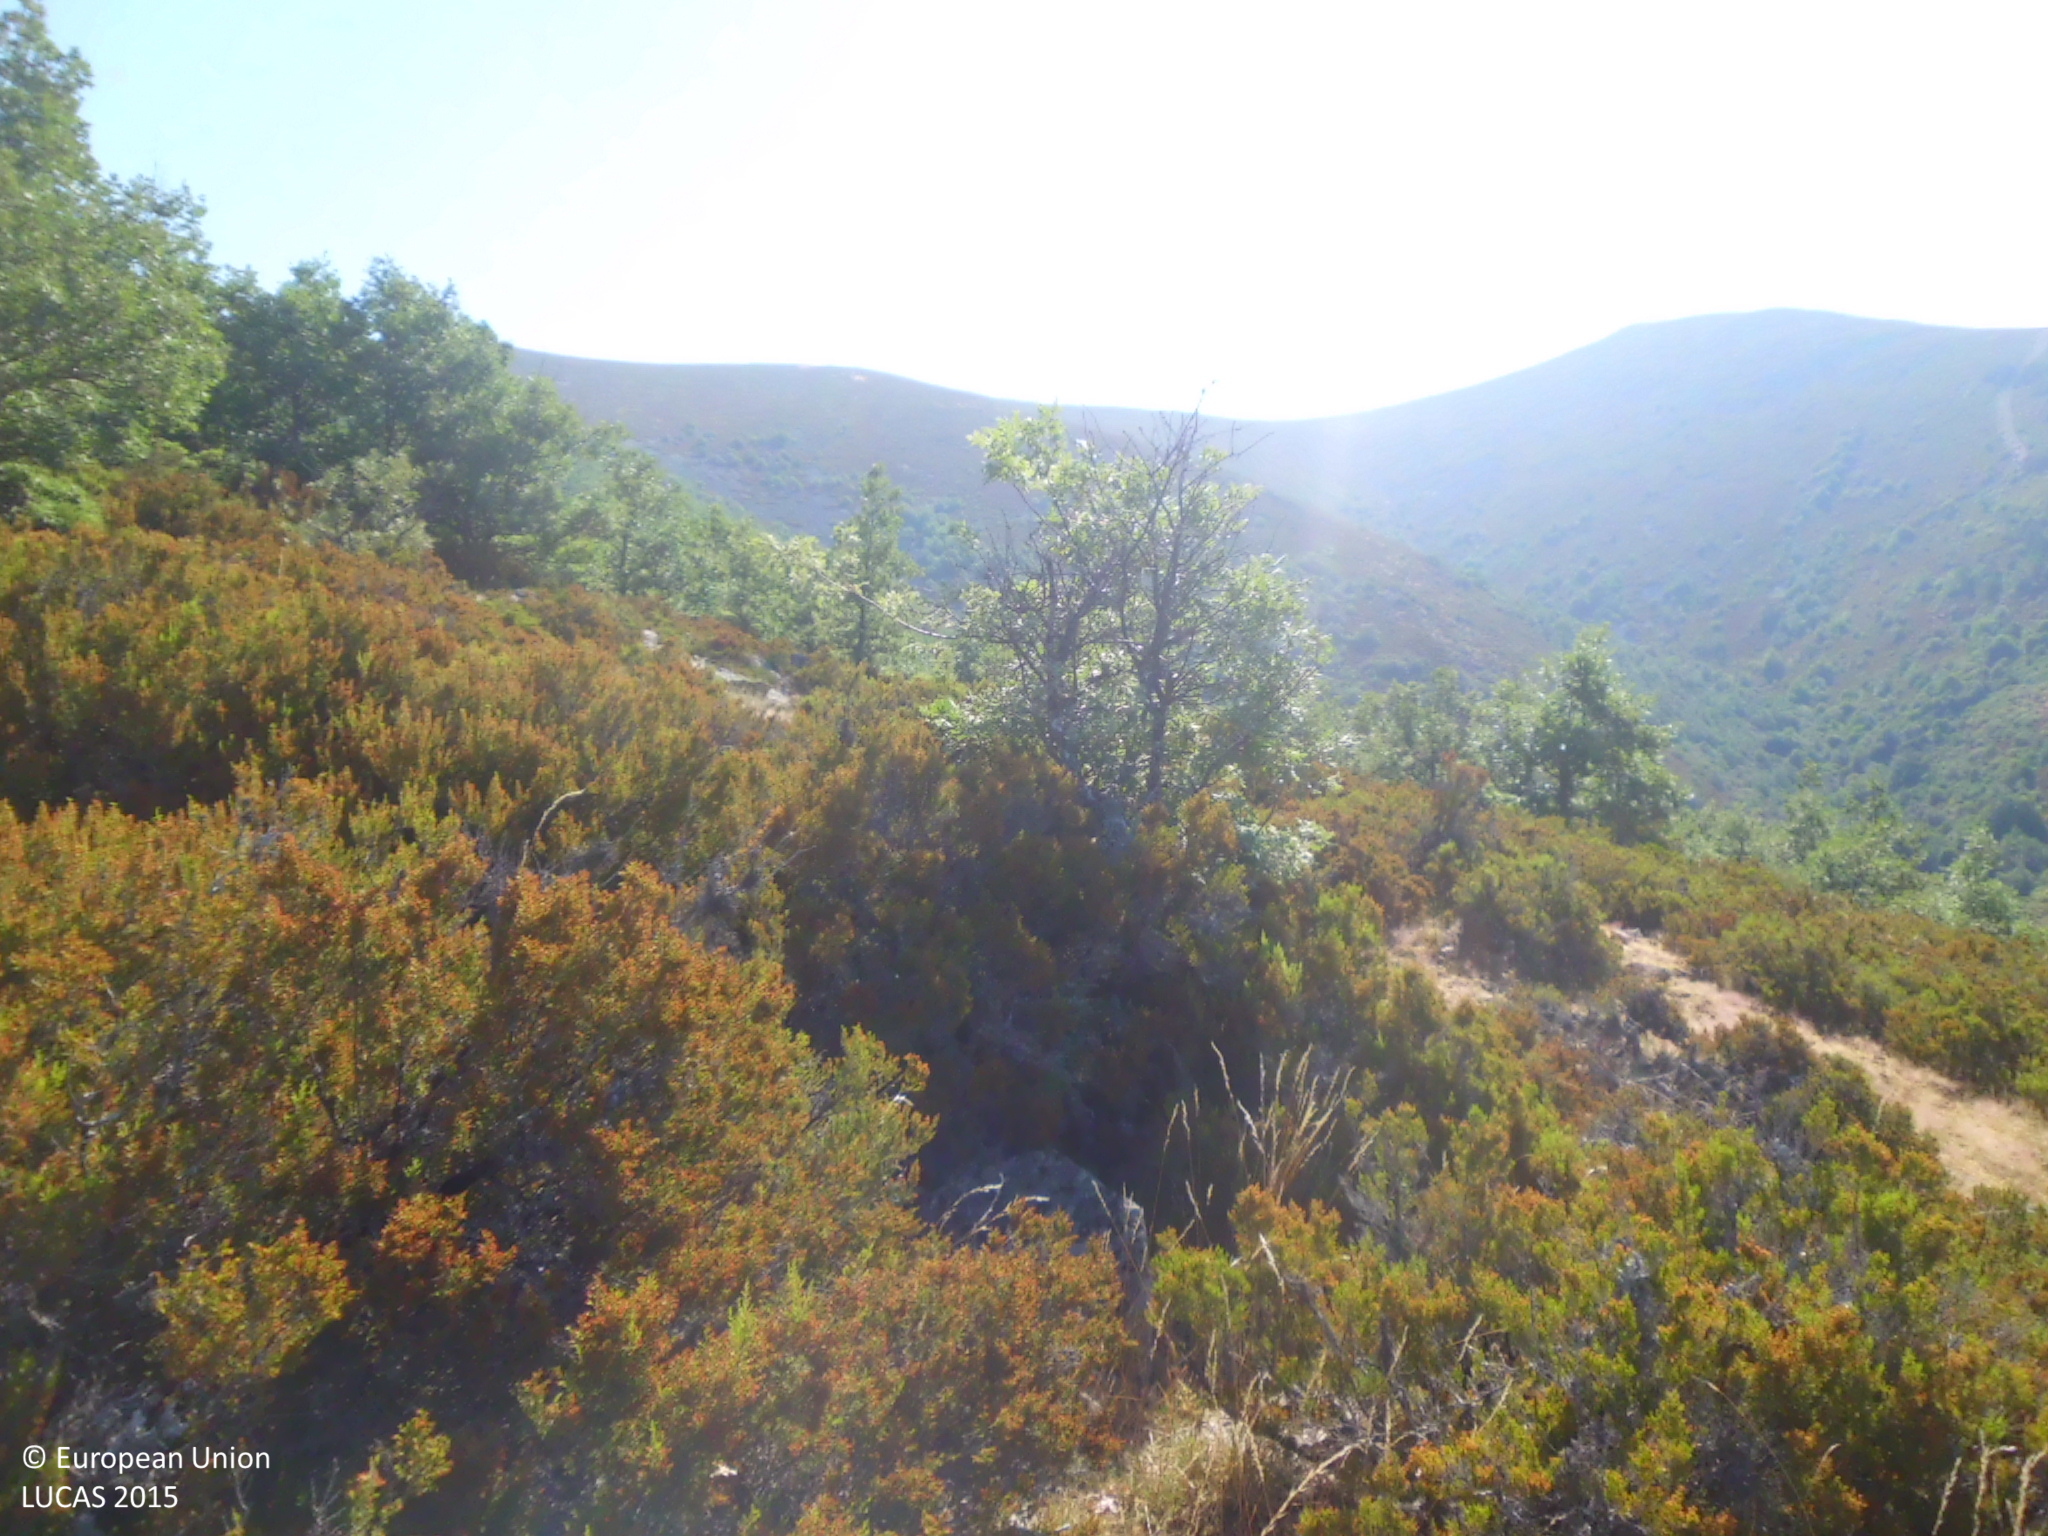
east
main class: Woodland
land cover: Broadleaved woodland
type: broadleaved evergreen forest
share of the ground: > 75 %
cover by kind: broadleaved forest trees 80 %, shrubs 20 %
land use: Forestry
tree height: > 5 m
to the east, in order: Broadleaved woodland
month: July
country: ES
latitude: 42.1881
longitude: -3.3366
